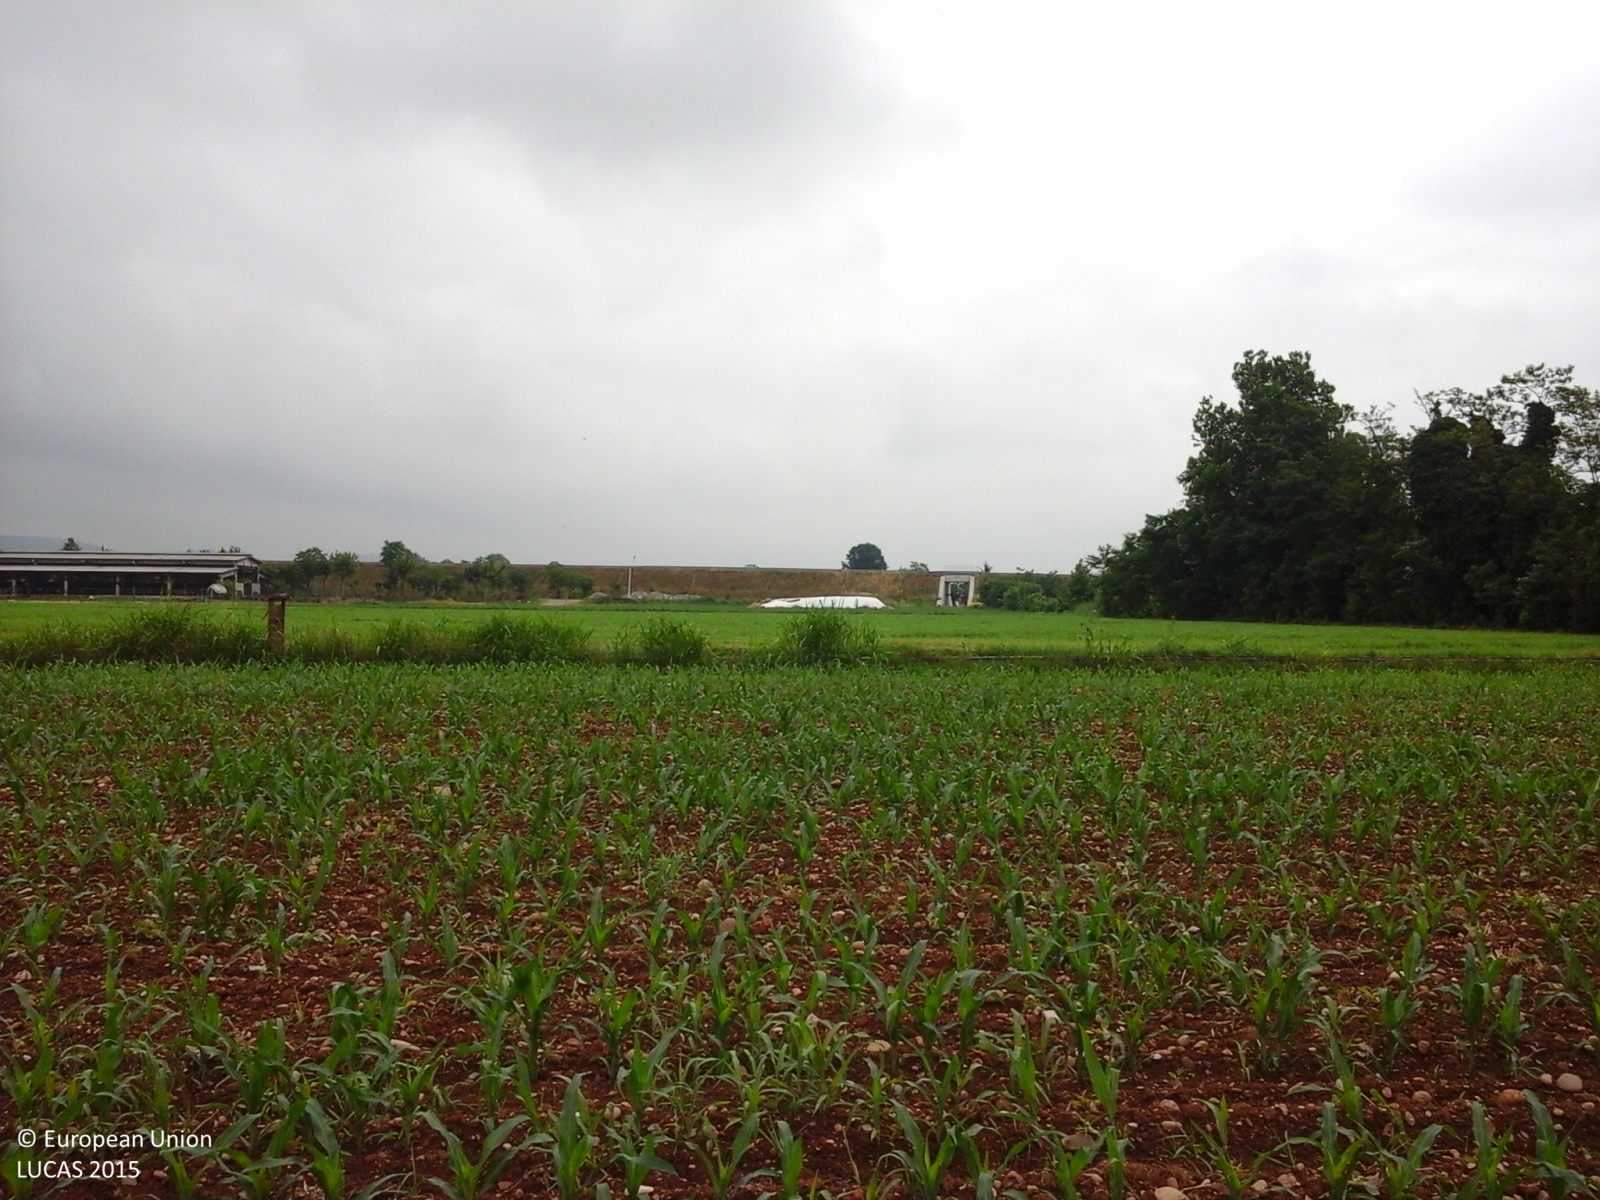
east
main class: Cropland
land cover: Maize
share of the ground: 10 - 25 %
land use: Agriculture (excluding fallow land and kitchen gardens)
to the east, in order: Maize; Other structural elements; Other cereals; Lucerne; Other bare soil
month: June
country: IT
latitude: 45.5584
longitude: 9.9105
